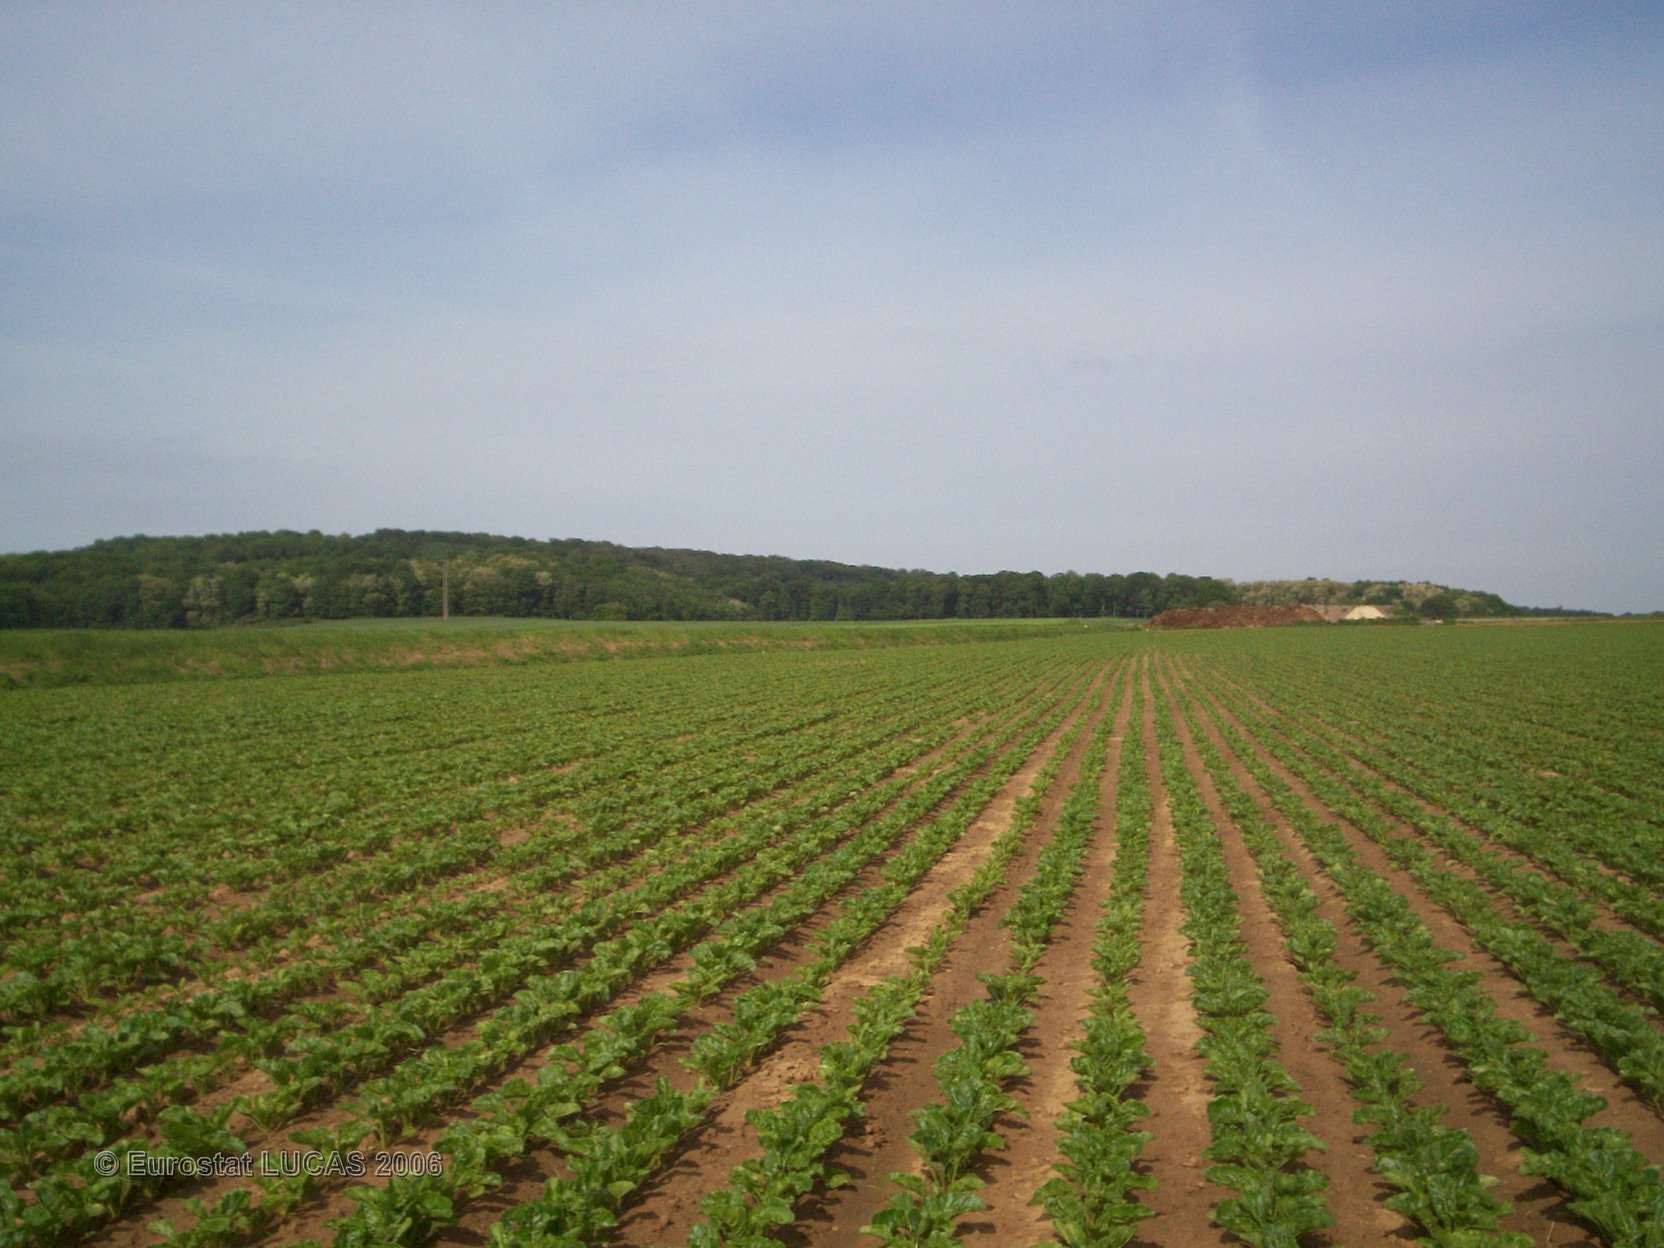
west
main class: Cropland
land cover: Sugar beet
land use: Agriculture (excluding fallow land and kitchen gardens)
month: June
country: FR
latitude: 49.2813
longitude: 2.6898
